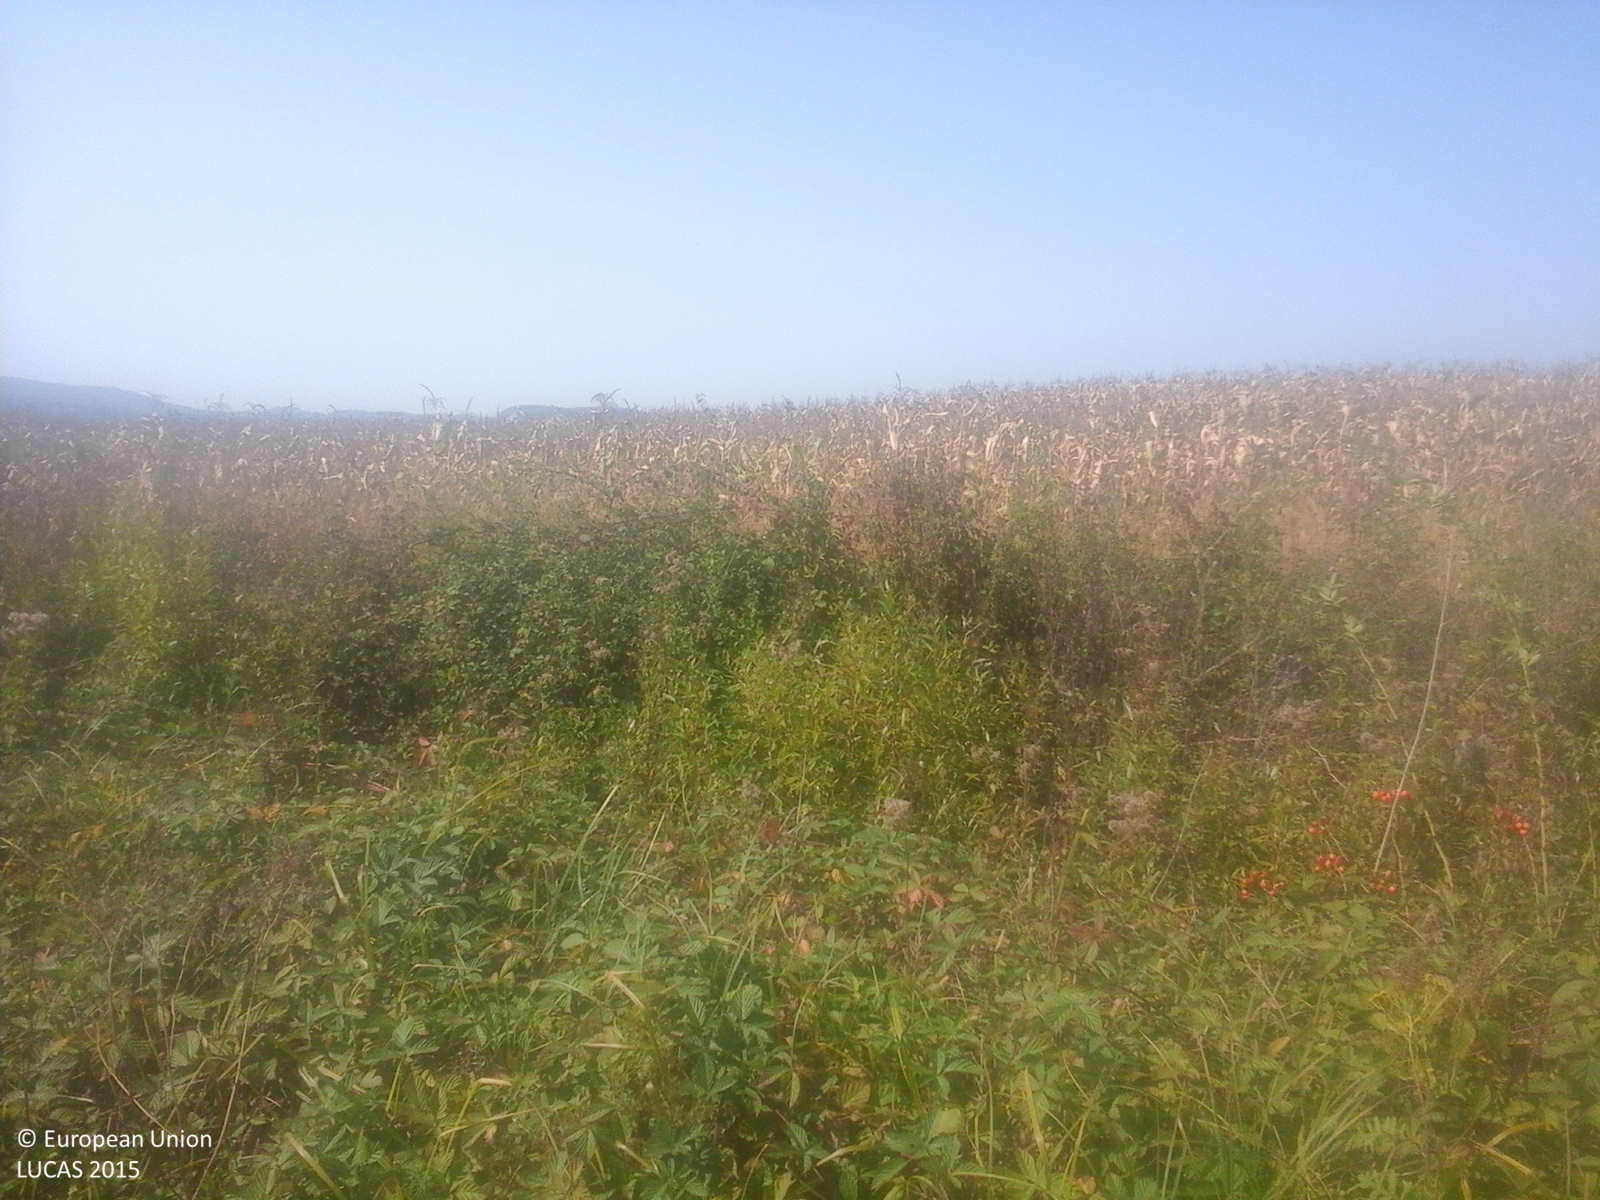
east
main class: Cropland
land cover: Maize
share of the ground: > 75 %
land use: Agriculture (excluding fallow land and kitchen gardens)
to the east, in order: Maize; Ditches and canals; Spontaneously vegetated surfaces; Grassland with sparse tree/shrub cover; Lucerne; Shruby margins; Ditches and canals; Shruby margins; Paved roads, cycling and walking lanes; Shruby margins; Abandoned hedges
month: September
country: RO
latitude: 46.6733
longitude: 22.3243
